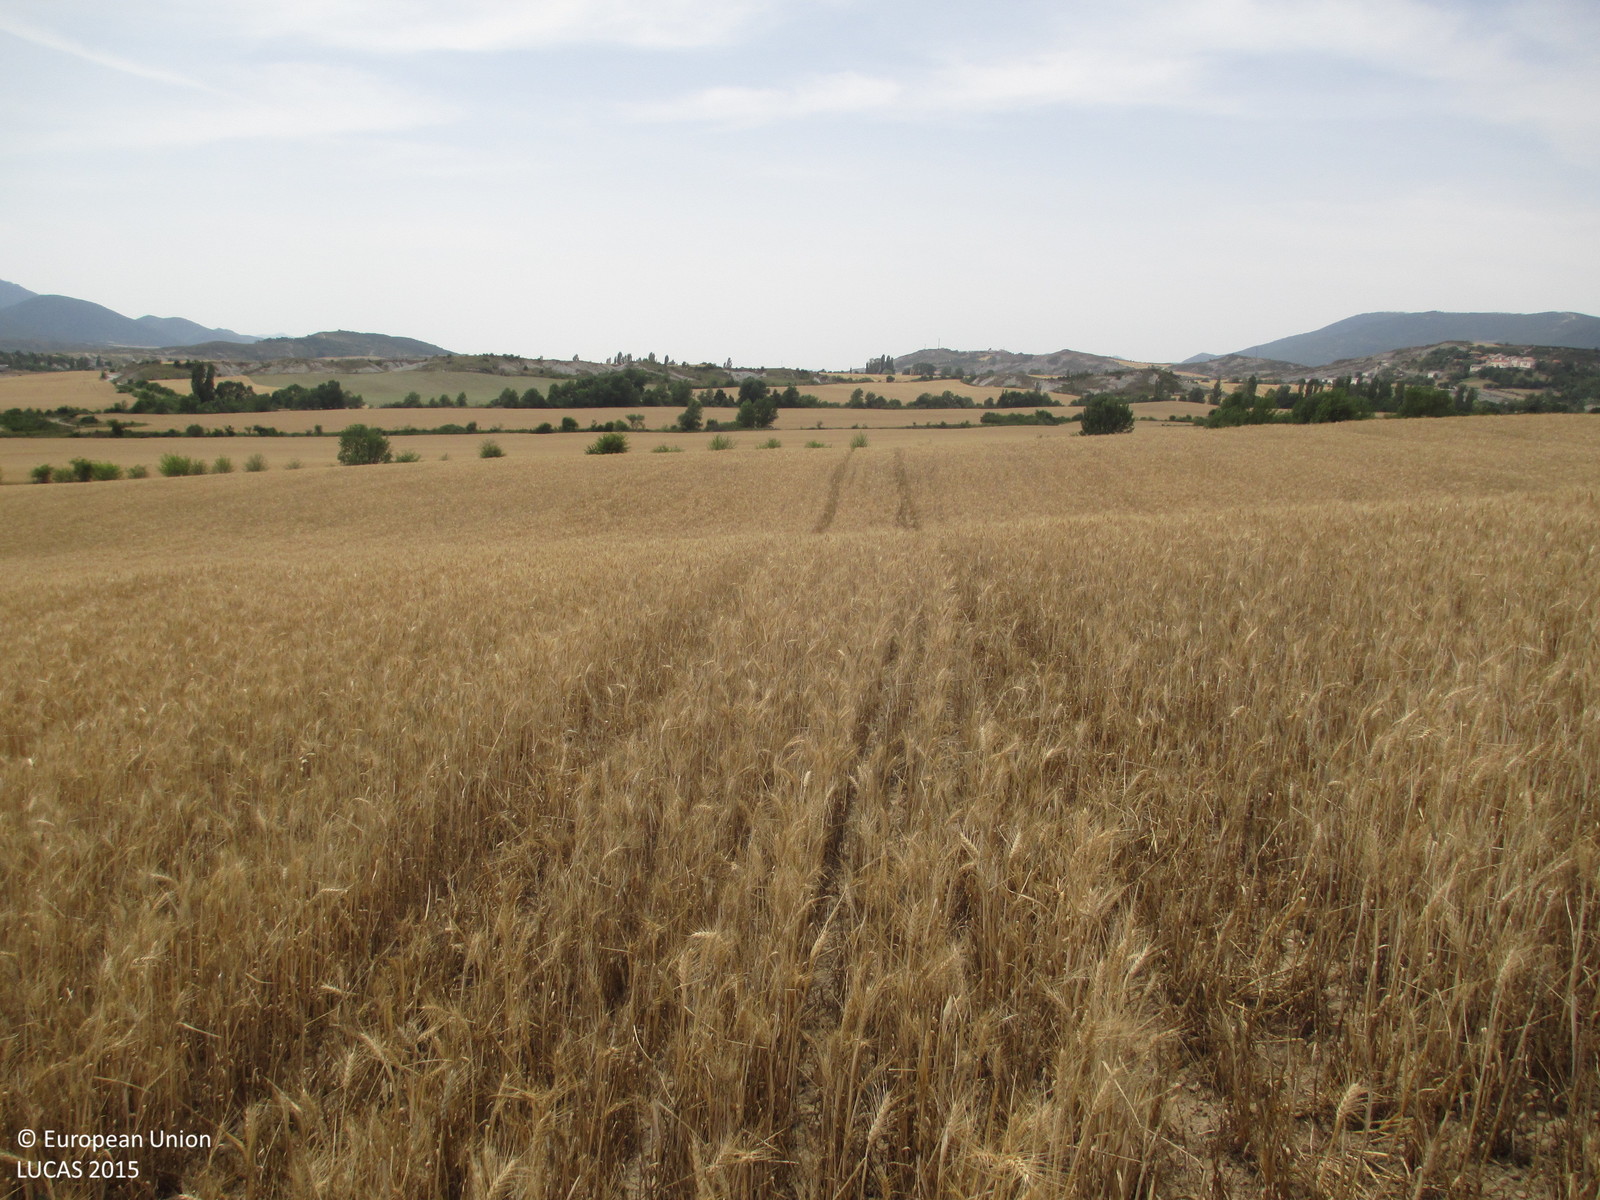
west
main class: Cropland
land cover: Common wheat
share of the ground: > 75 %
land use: Agriculture (excluding fallow land and kitchen gardens)
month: July
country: ES
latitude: 42.5524
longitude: -0.4144
